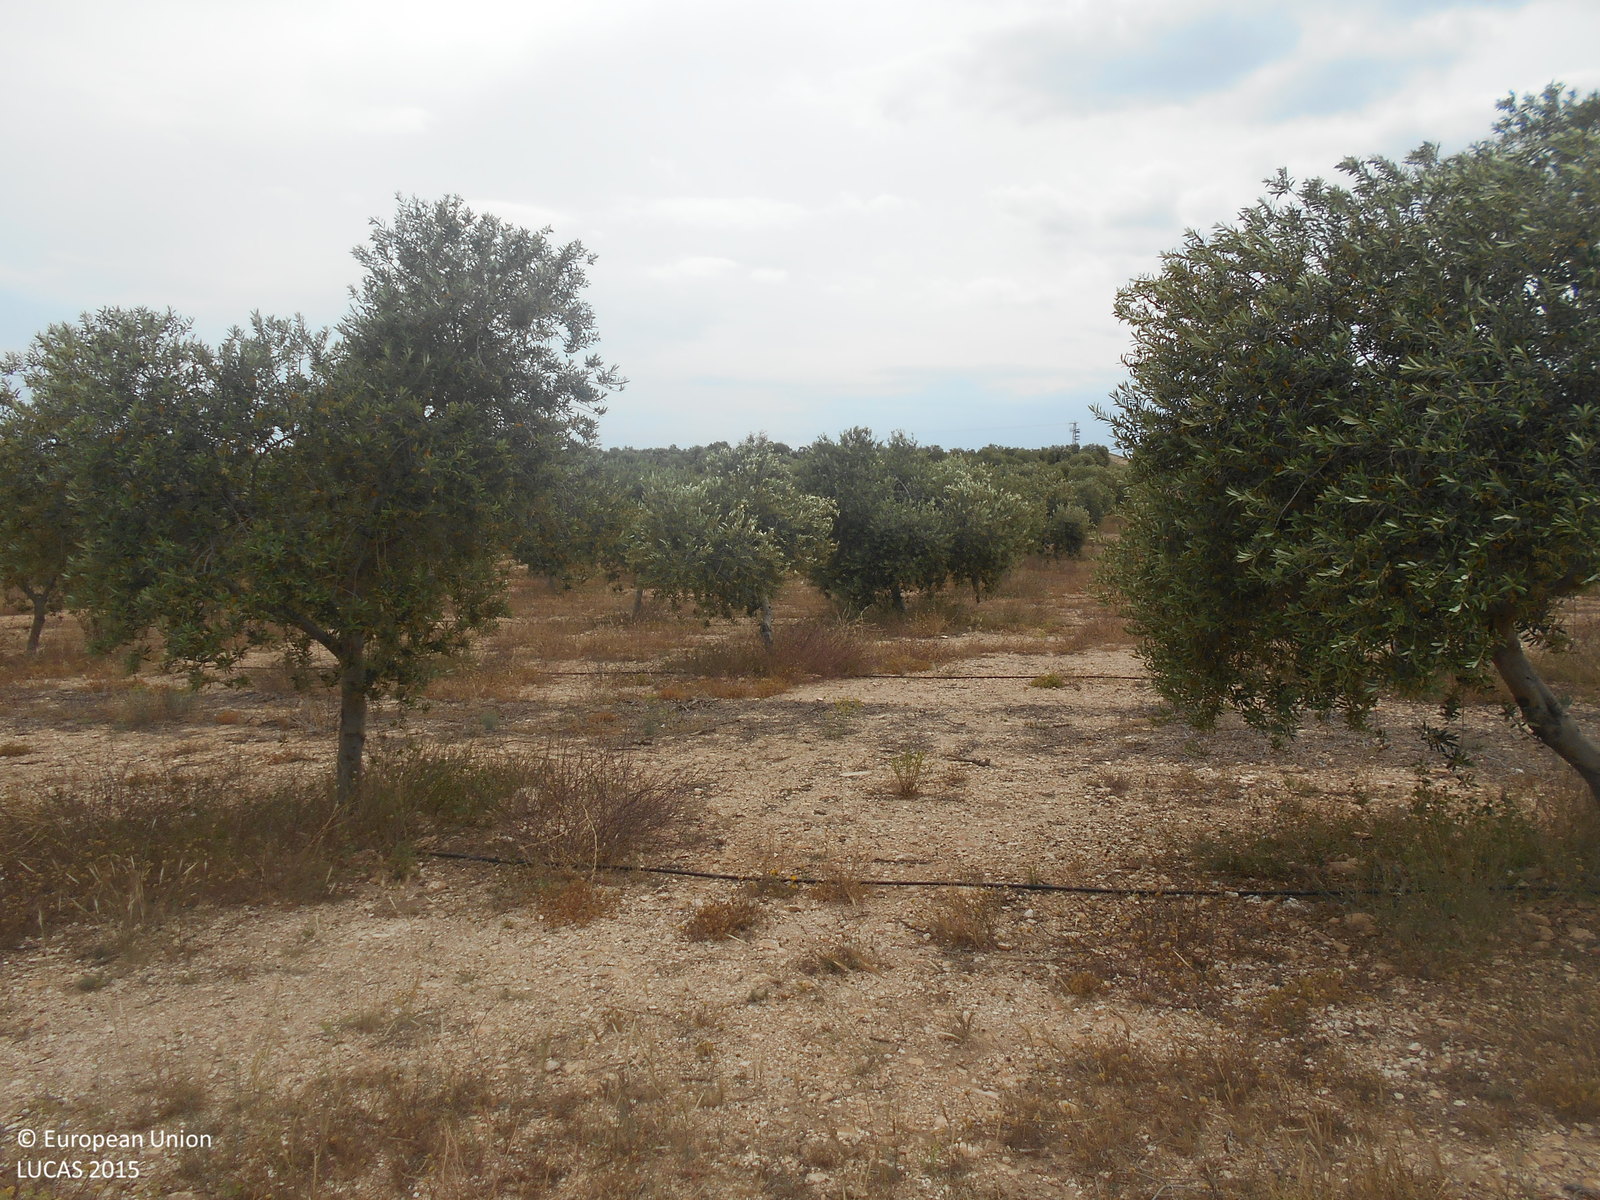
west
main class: Cropland
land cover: Olive groves
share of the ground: 25 - 50 %
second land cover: Spontaneously vegetated surfaces
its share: 10 - 25 %
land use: Agriculture (excluding fallow land and kitchen gardens)
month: May
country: ES
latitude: 37.1135
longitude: -2.2785
